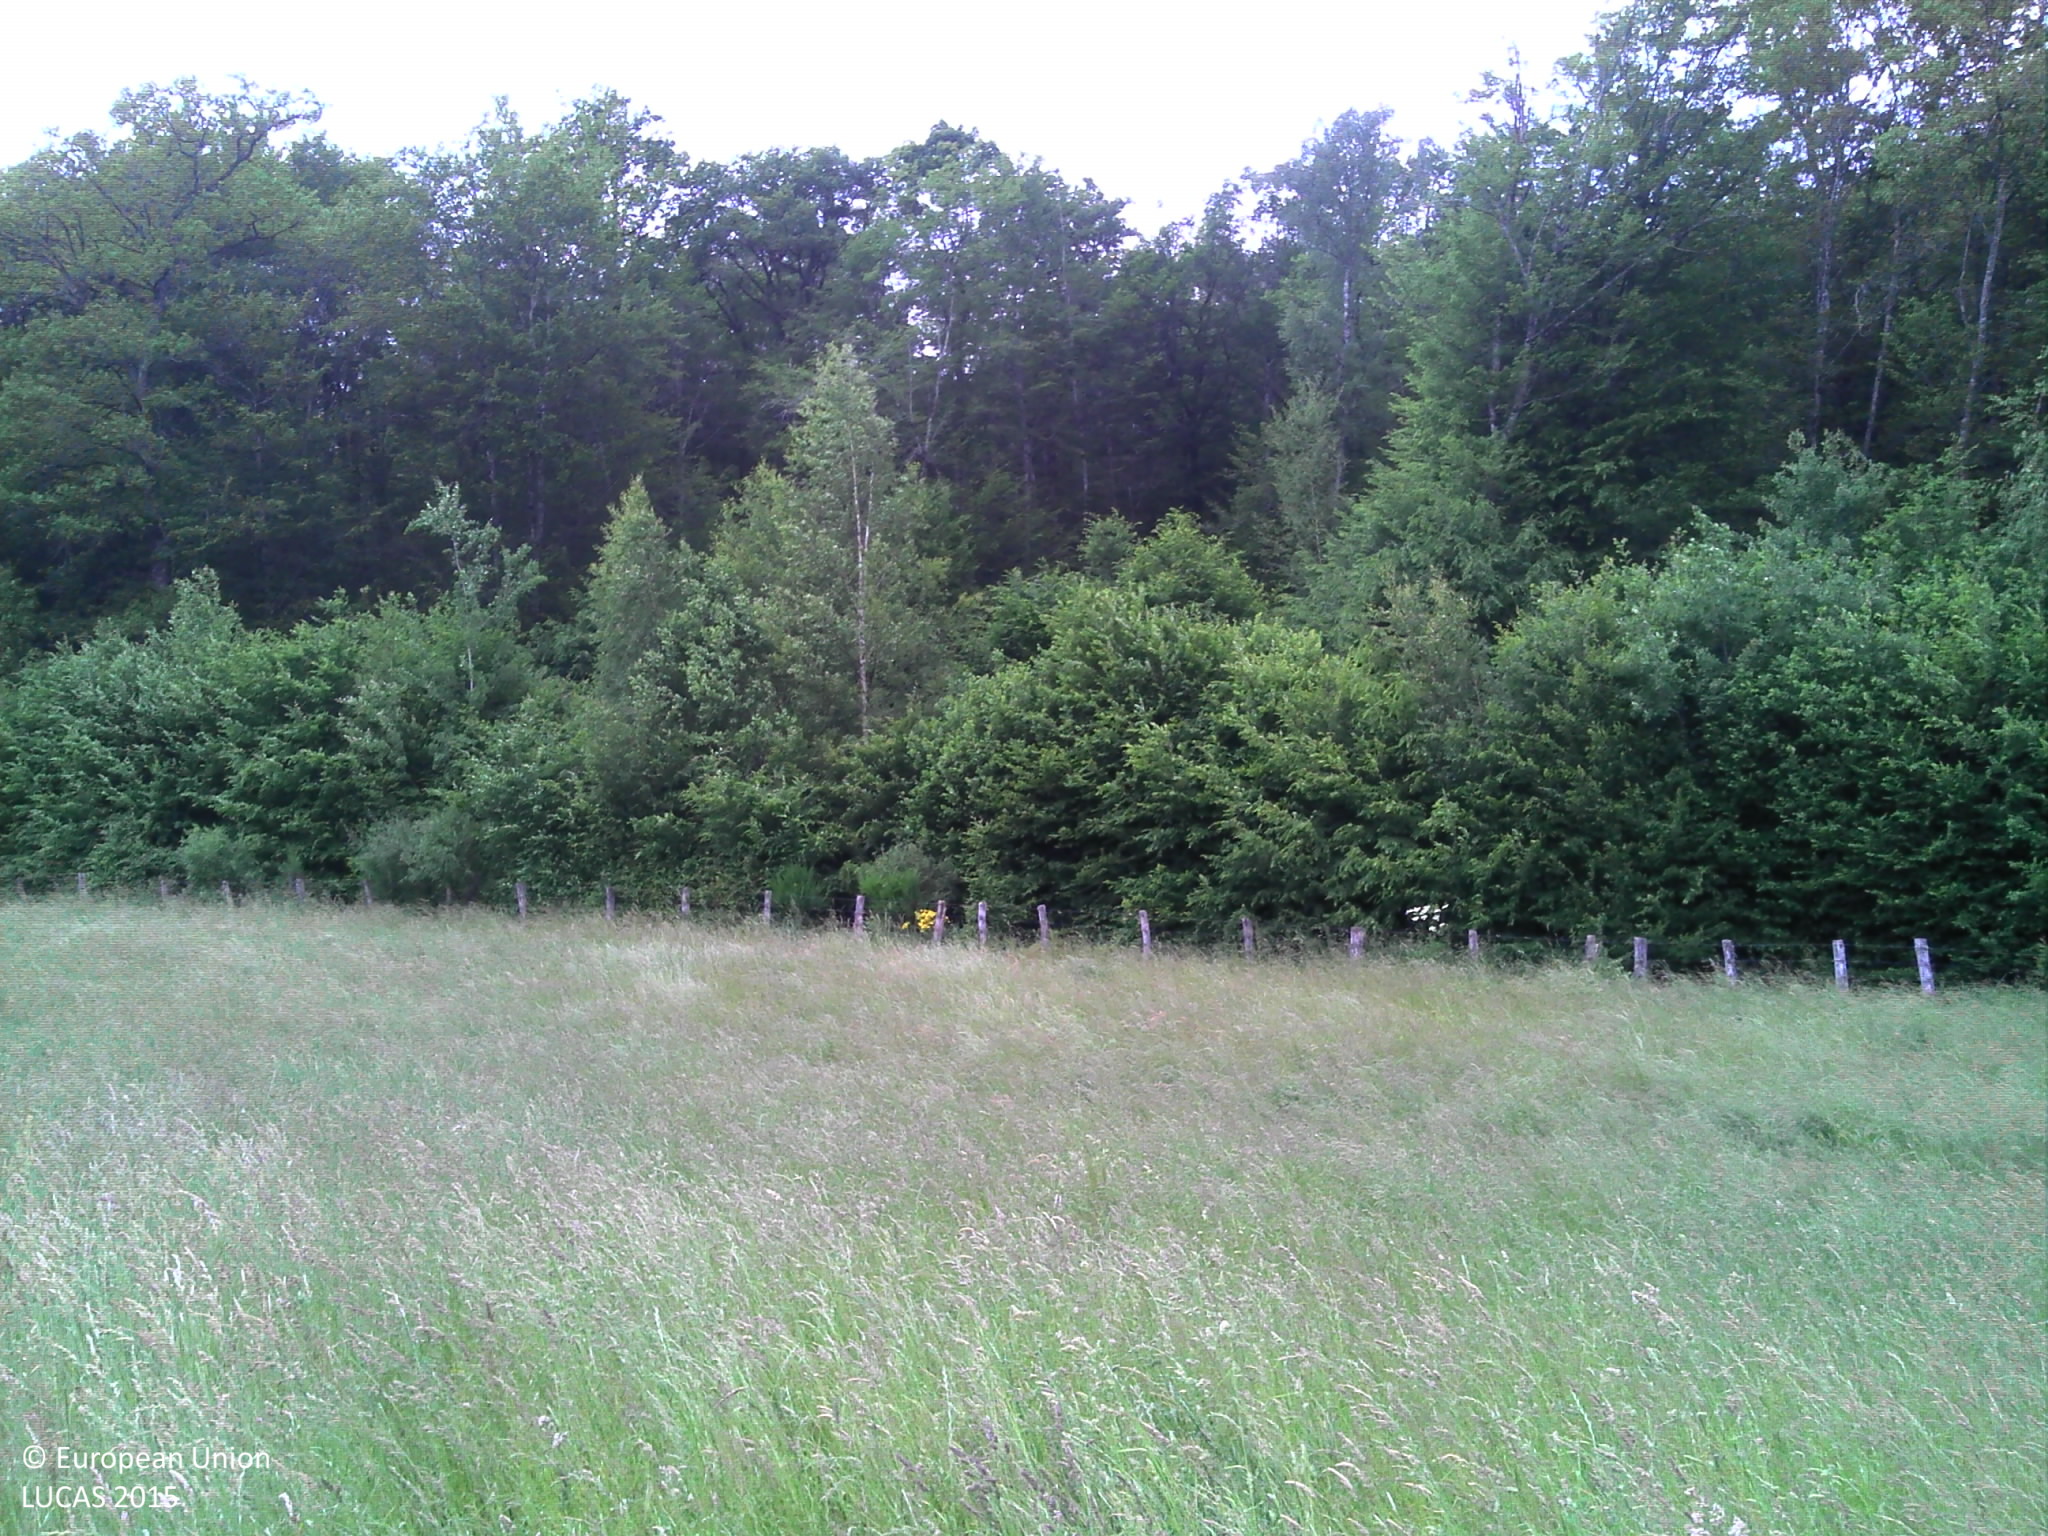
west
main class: Grassland
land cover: Grassland without tree/shrub cover
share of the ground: > 75 %
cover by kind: herbaceous plants 100 %
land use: Agriculture (excluding fallow land and kitchen gardens)
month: June
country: FR
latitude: 47.4401
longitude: 3.8847
